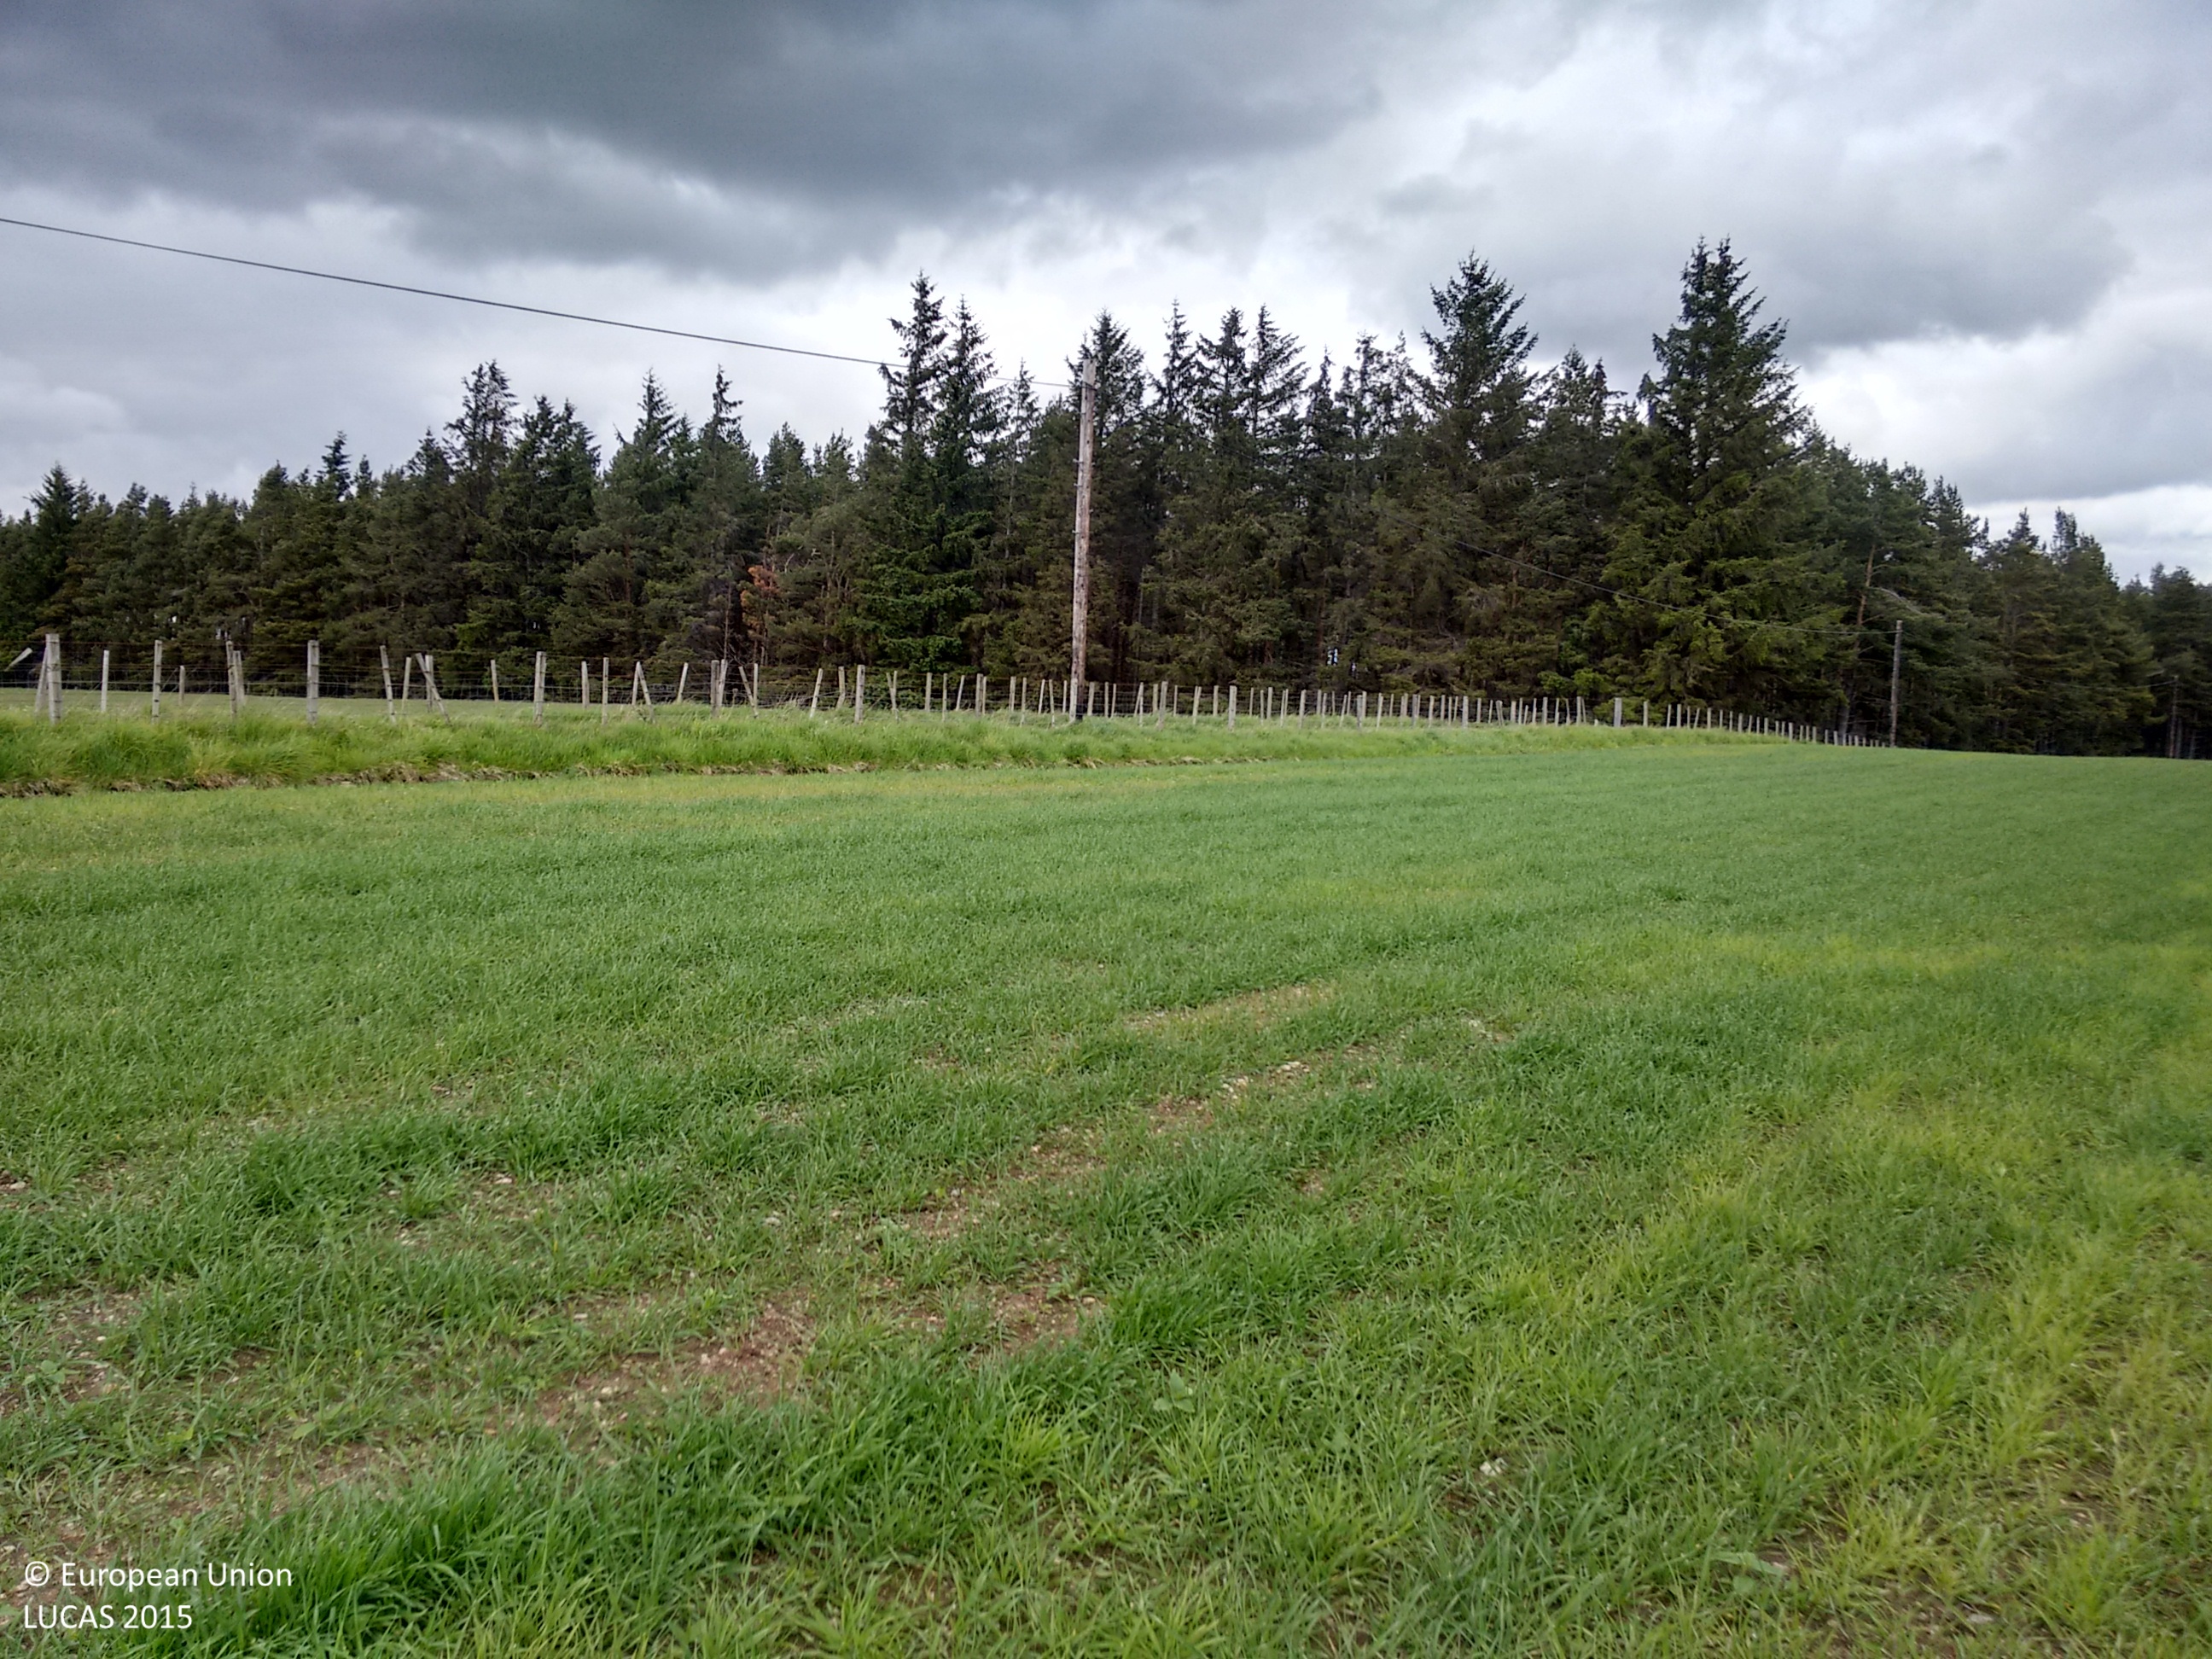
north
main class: Cropland
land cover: Barley
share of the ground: > 75 %
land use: Agriculture (excluding fallow land and kitchen gardens)
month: June
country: GB
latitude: 57.2134
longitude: -3.7702
